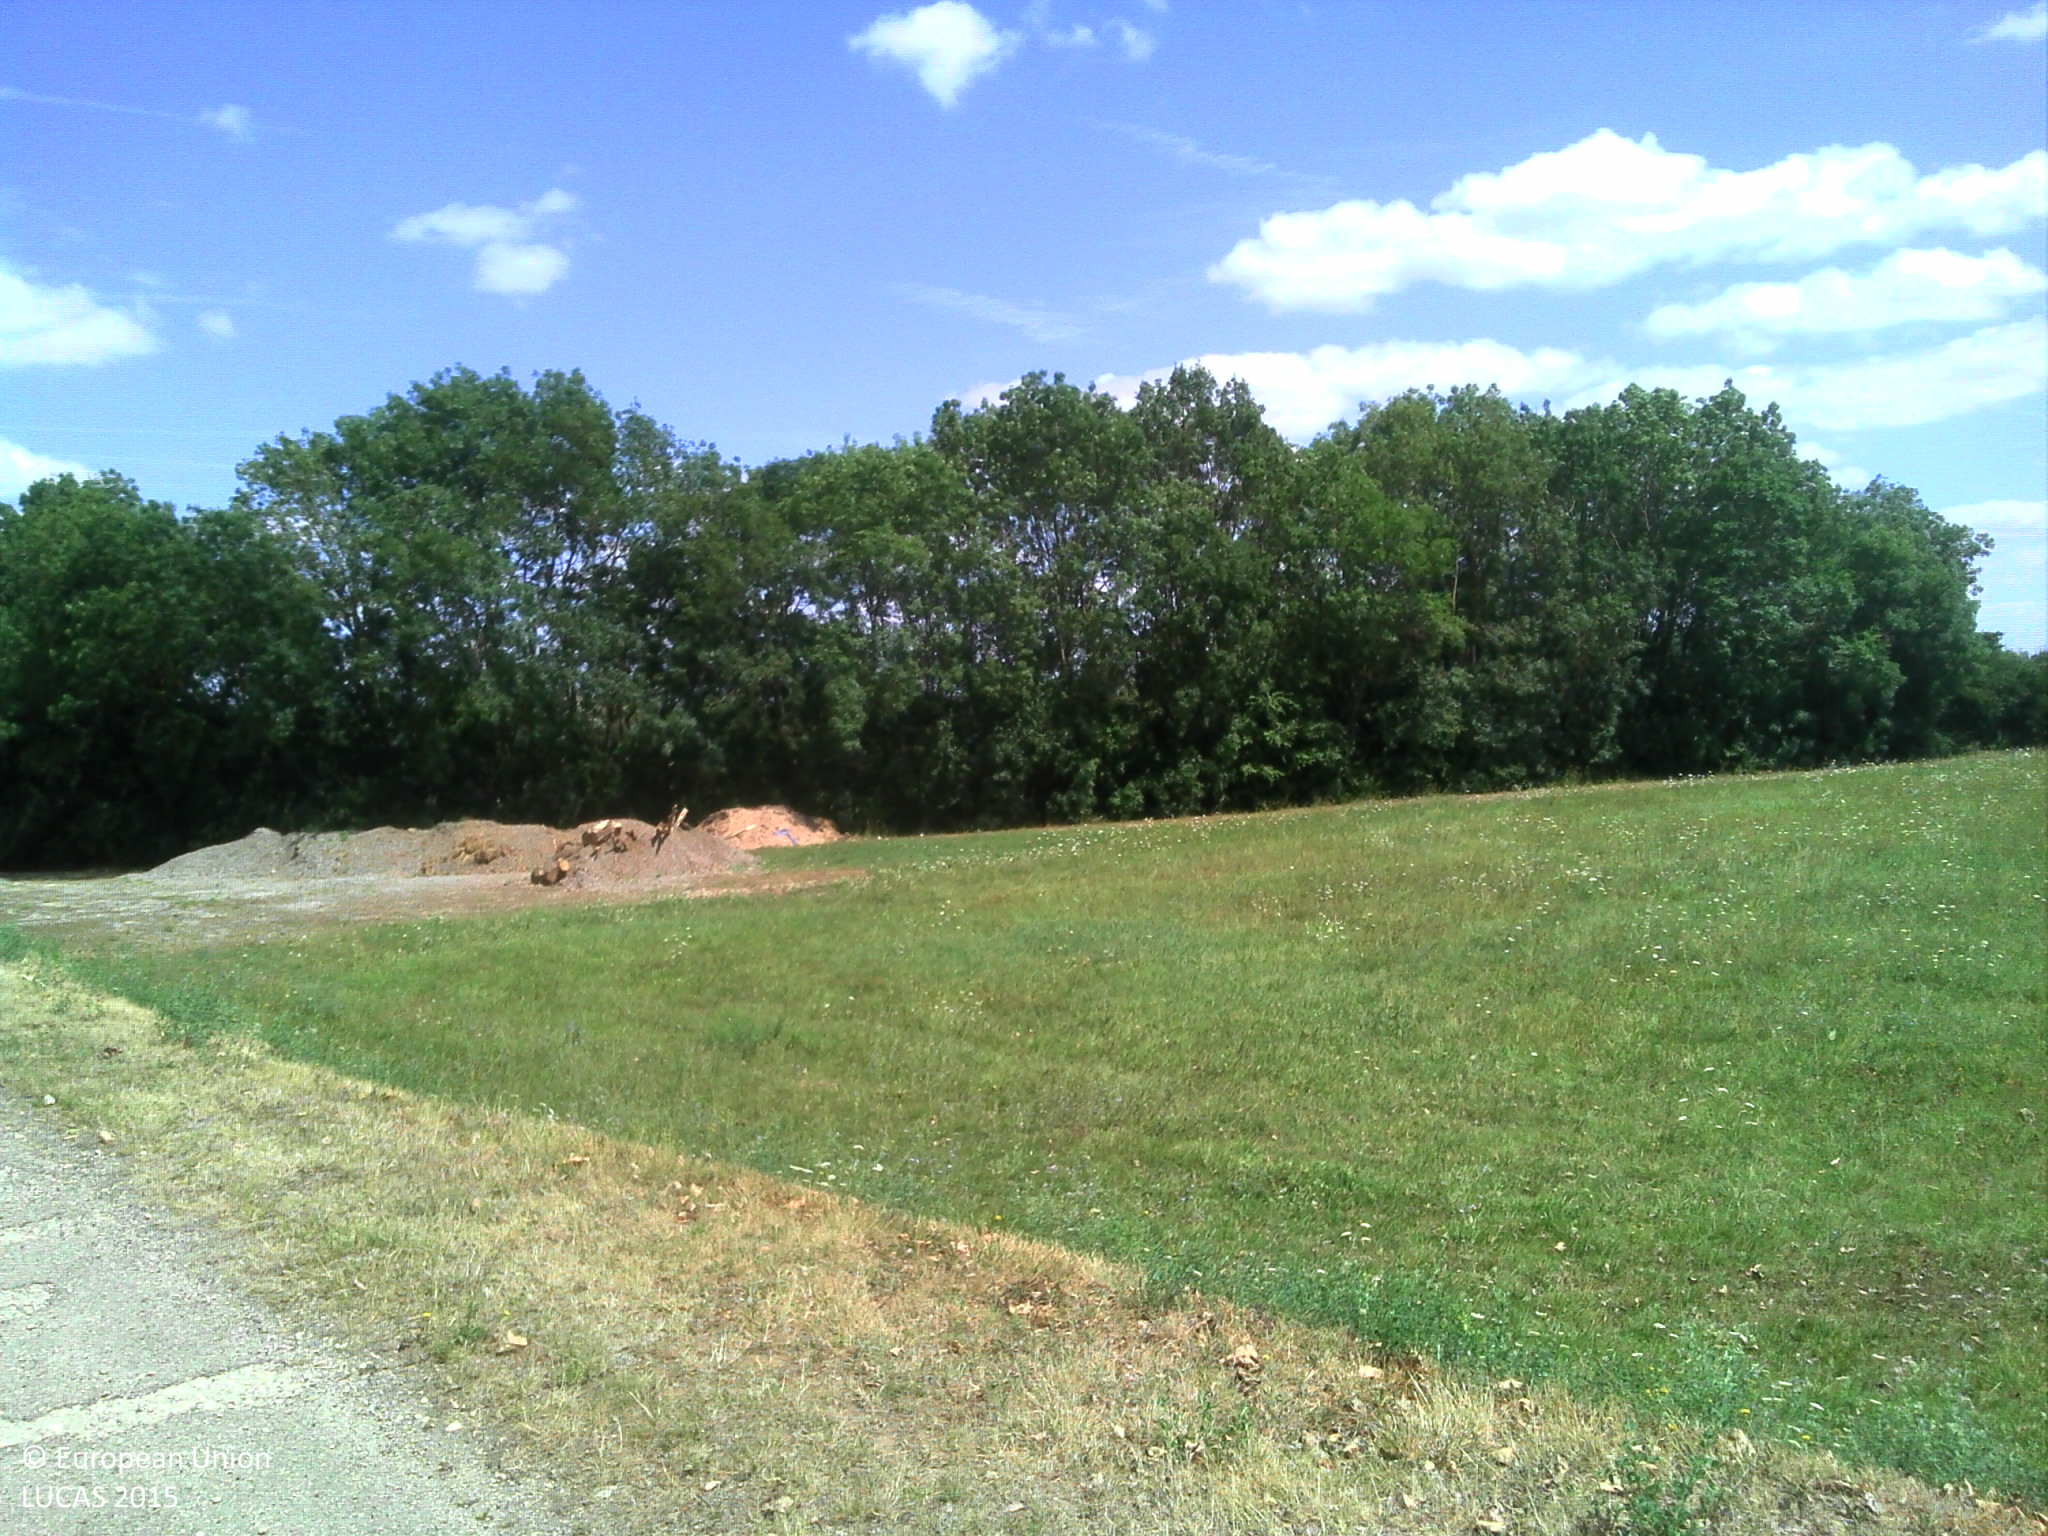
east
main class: Woodland
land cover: Broadleaved woodland
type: floodplain forest
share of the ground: > 75 %
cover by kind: broadleaved forest trees 60 %, herbaceous plants 30 %
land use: Amenities, museums, leisure
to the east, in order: Paved roads, cycling and walking lanes; Grass margins; Lines of trees; Tracks; Grassland without tree/shrub cover; Tracks; Broadleaved woodland; Artificial constructions in urban areas; Grassland without tree/shrub cover; Ditches and canals; Paved roads, cycling and walking lanes; Grassland without tree/shrub cover; Tracks; Common wheat
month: July
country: FR
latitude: 46.7880
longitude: 4.8794
